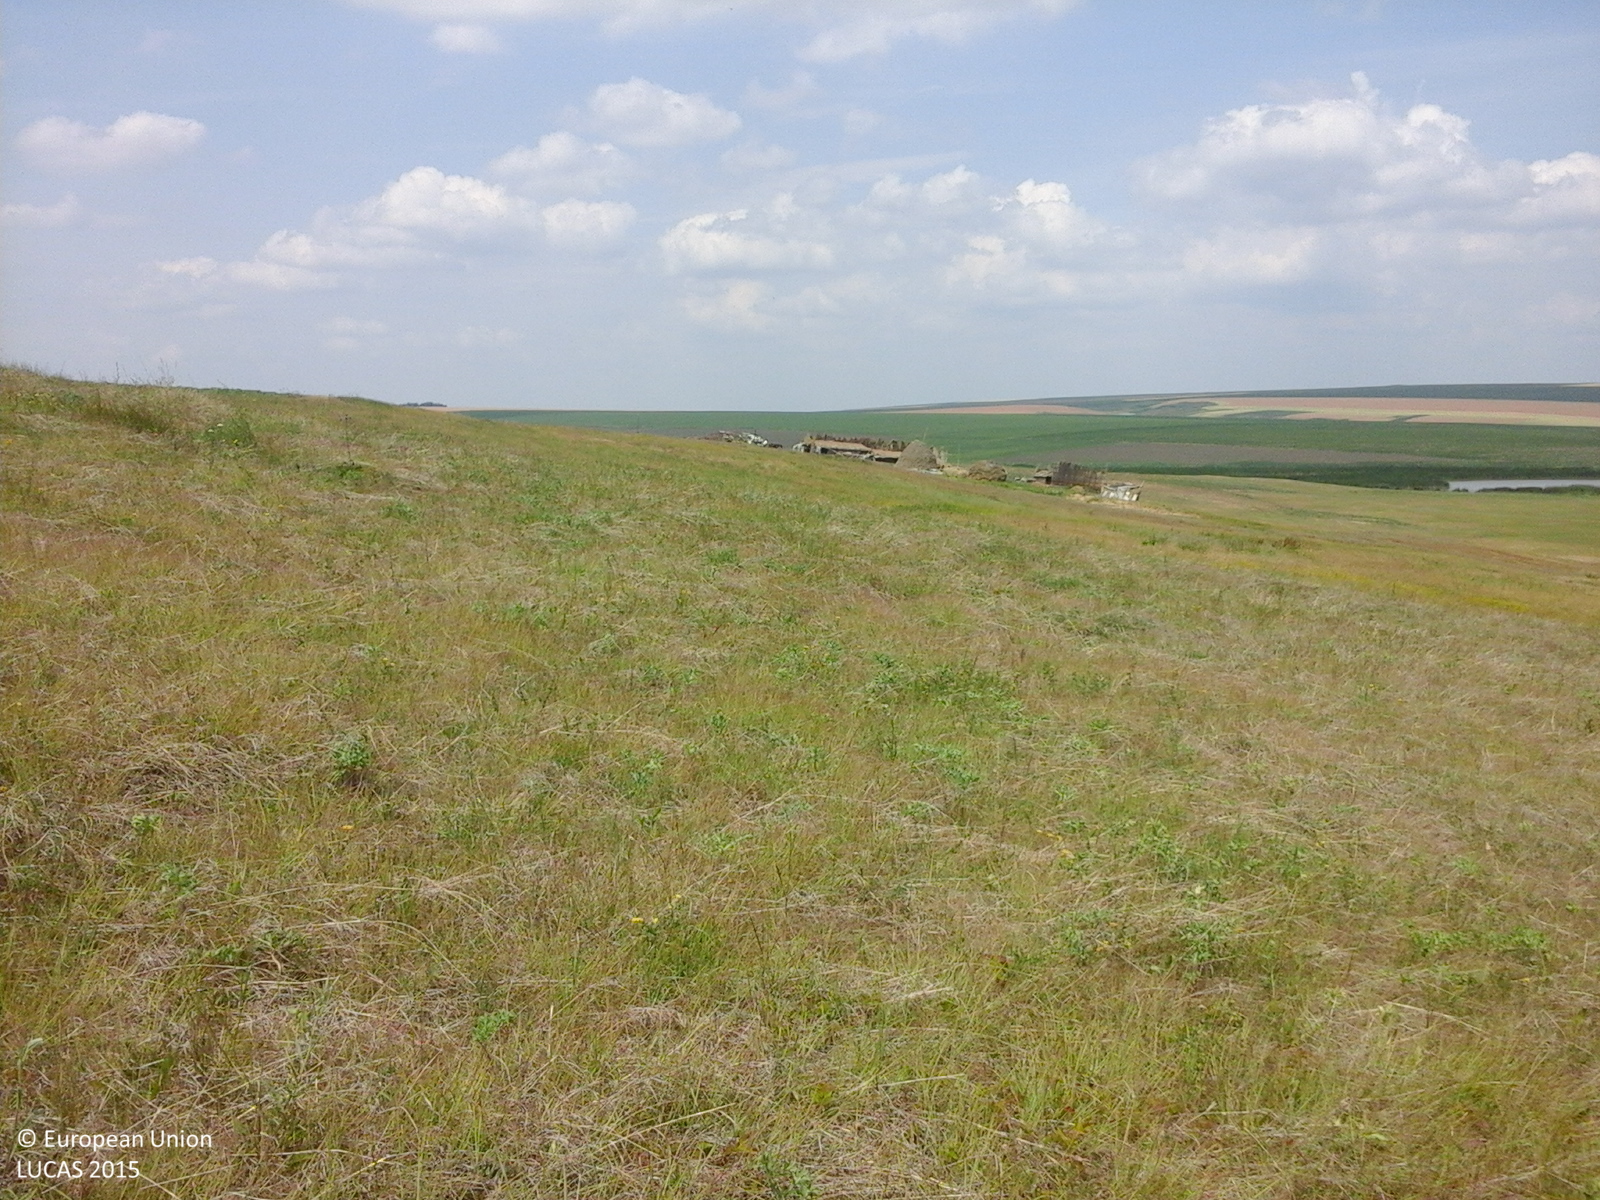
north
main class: Grassland
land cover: Grassland without tree/shrub cover
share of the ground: > 75 %
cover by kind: herbaceous plants 100 %
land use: Agriculture (excluding fallow land and kitchen gardens)
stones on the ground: < 10 %
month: June
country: RO
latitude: 47.4309
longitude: 26.9520
